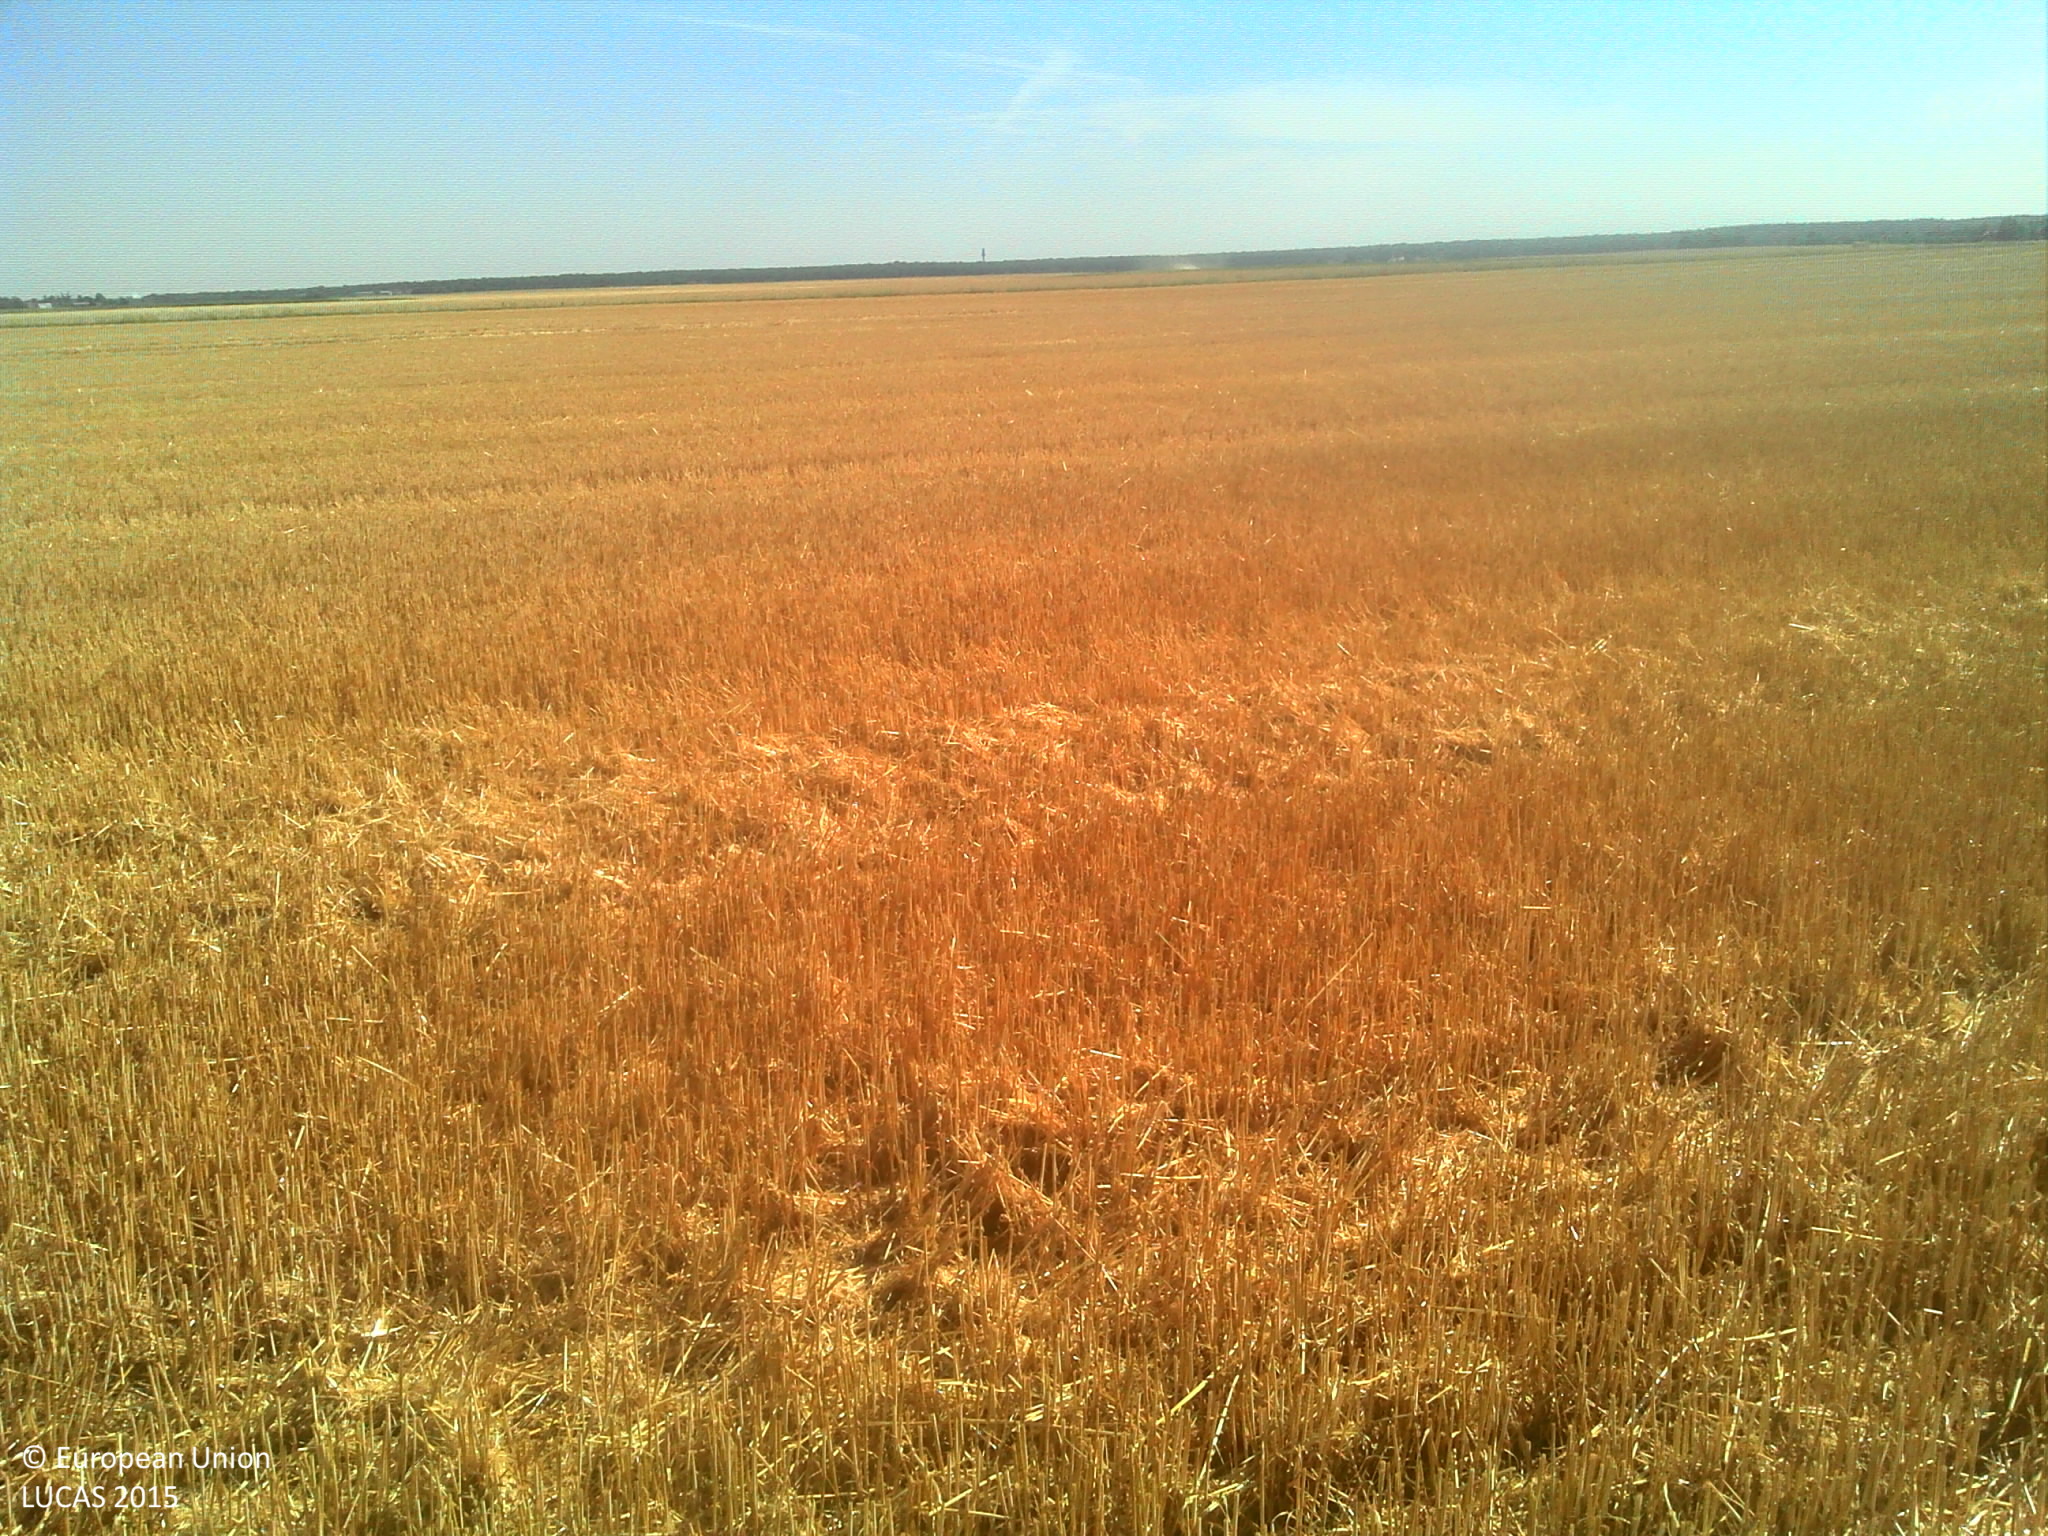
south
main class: Cropland
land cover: Common wheat
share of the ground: > 75 %
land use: Agriculture (excluding fallow land and kitchen gardens)
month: July
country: FR
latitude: 47.8921
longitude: 1.4649
